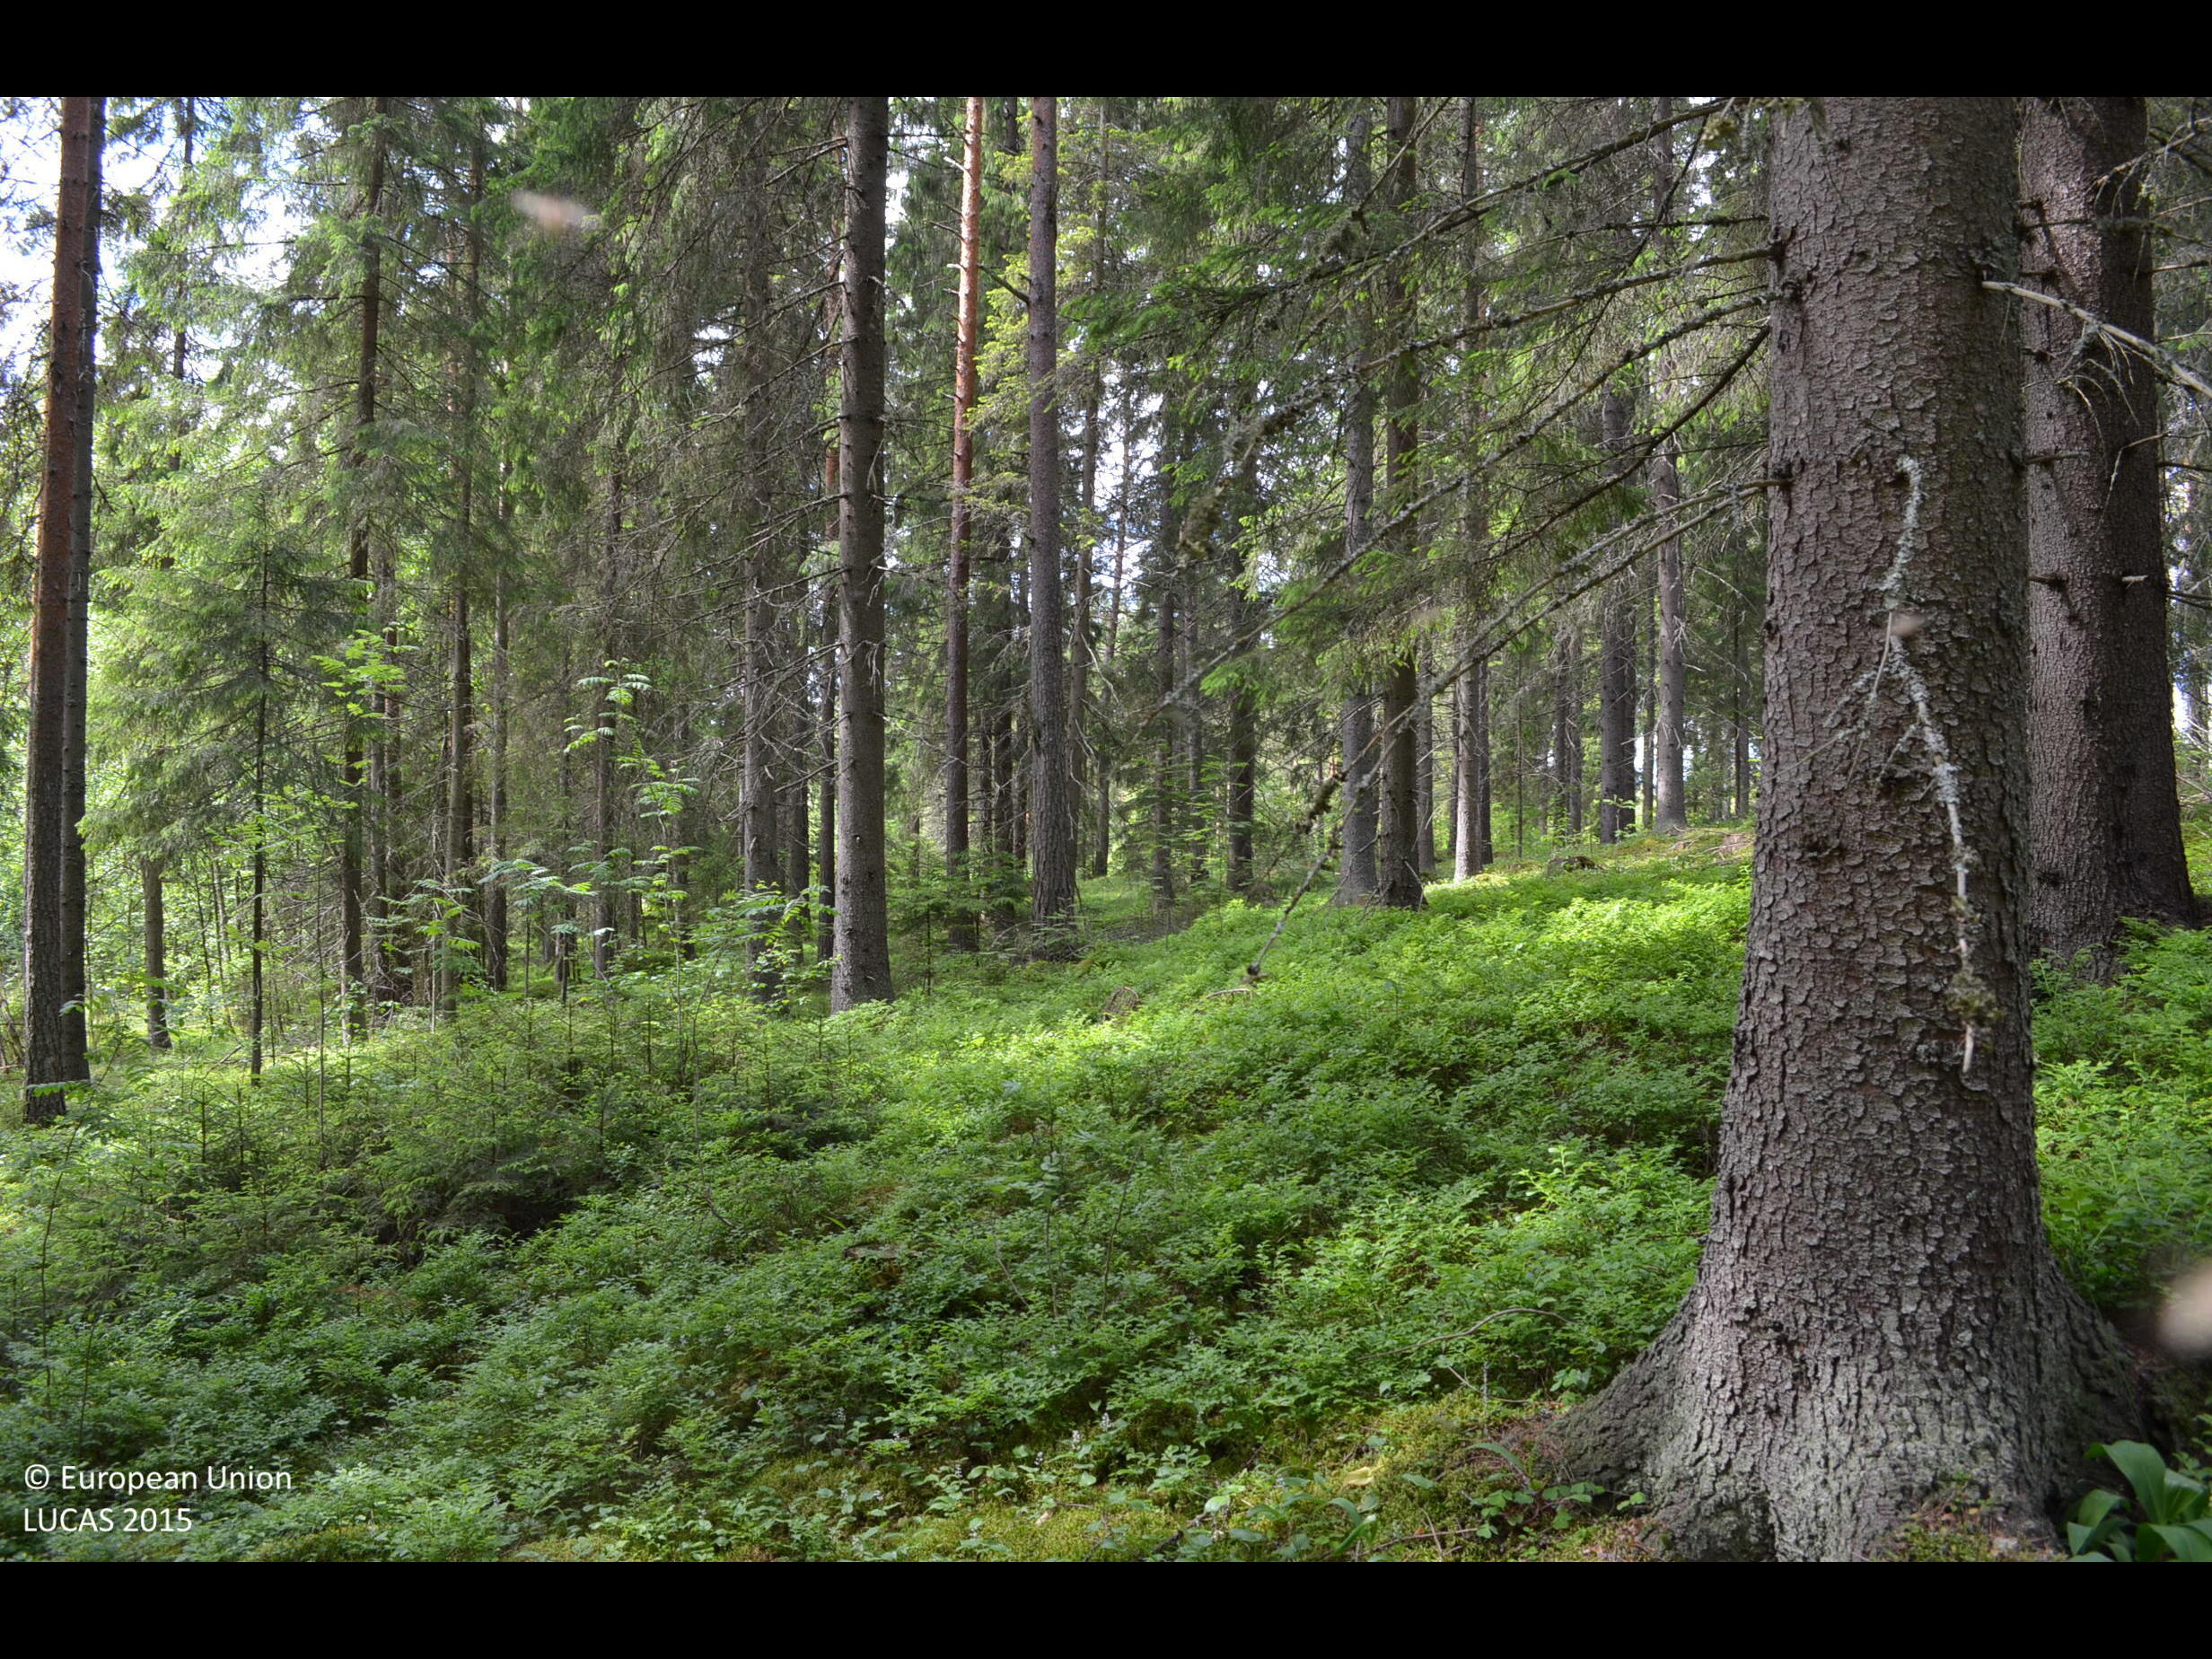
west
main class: Woodland
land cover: Other coniferous woodland
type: boreal forest
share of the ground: > 75 %
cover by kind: coniferous forest trees 80 %, shrubs 10 %, broadleaved forest trees 5 %, herbaceous plants 5 %
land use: Forestry
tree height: > 5 m
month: June
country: FI
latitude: 61.7818
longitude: 23.2875
